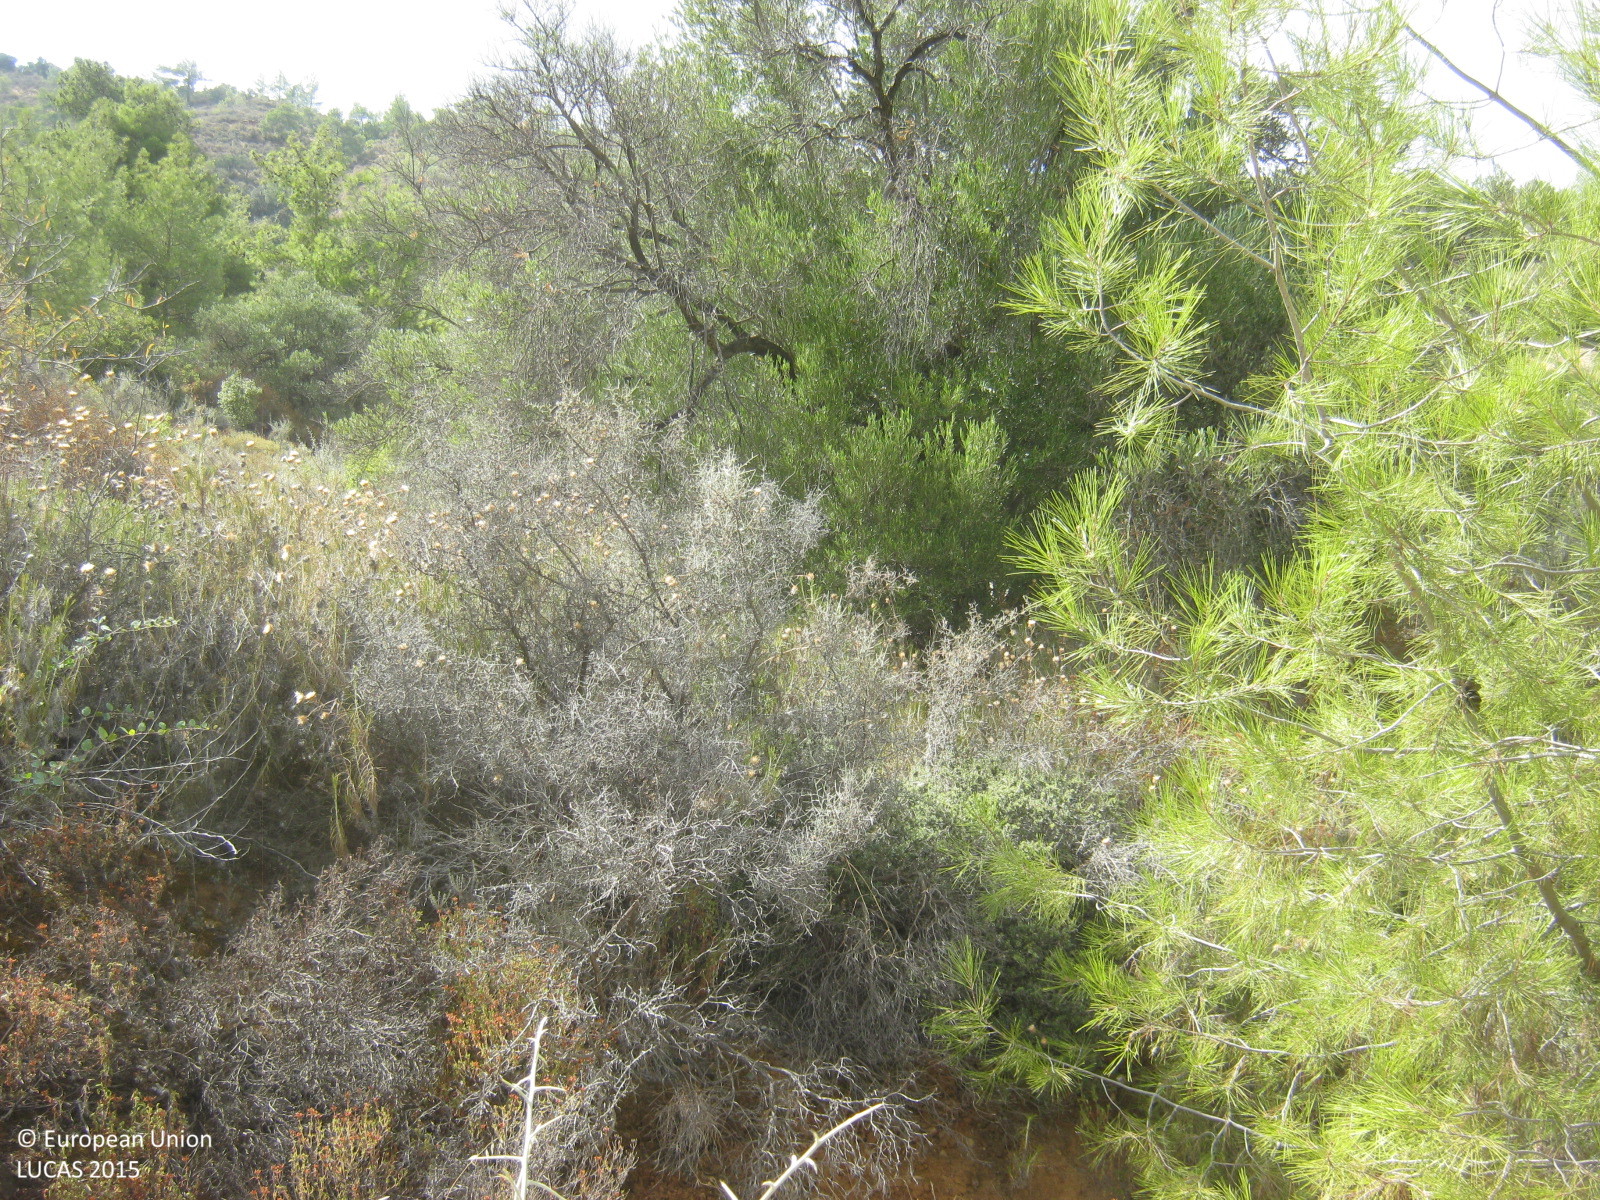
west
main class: Woodland
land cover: Other mixed woodland
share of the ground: 25 - 50 %
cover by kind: shrubs 30 %, herbaceous plants 30 %, broadleaved forest trees 25 %, coniferous forest trees 15 %
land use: Semi-natural and natural areas not in use
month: September
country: CY
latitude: 35.0265
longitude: 32.8228
